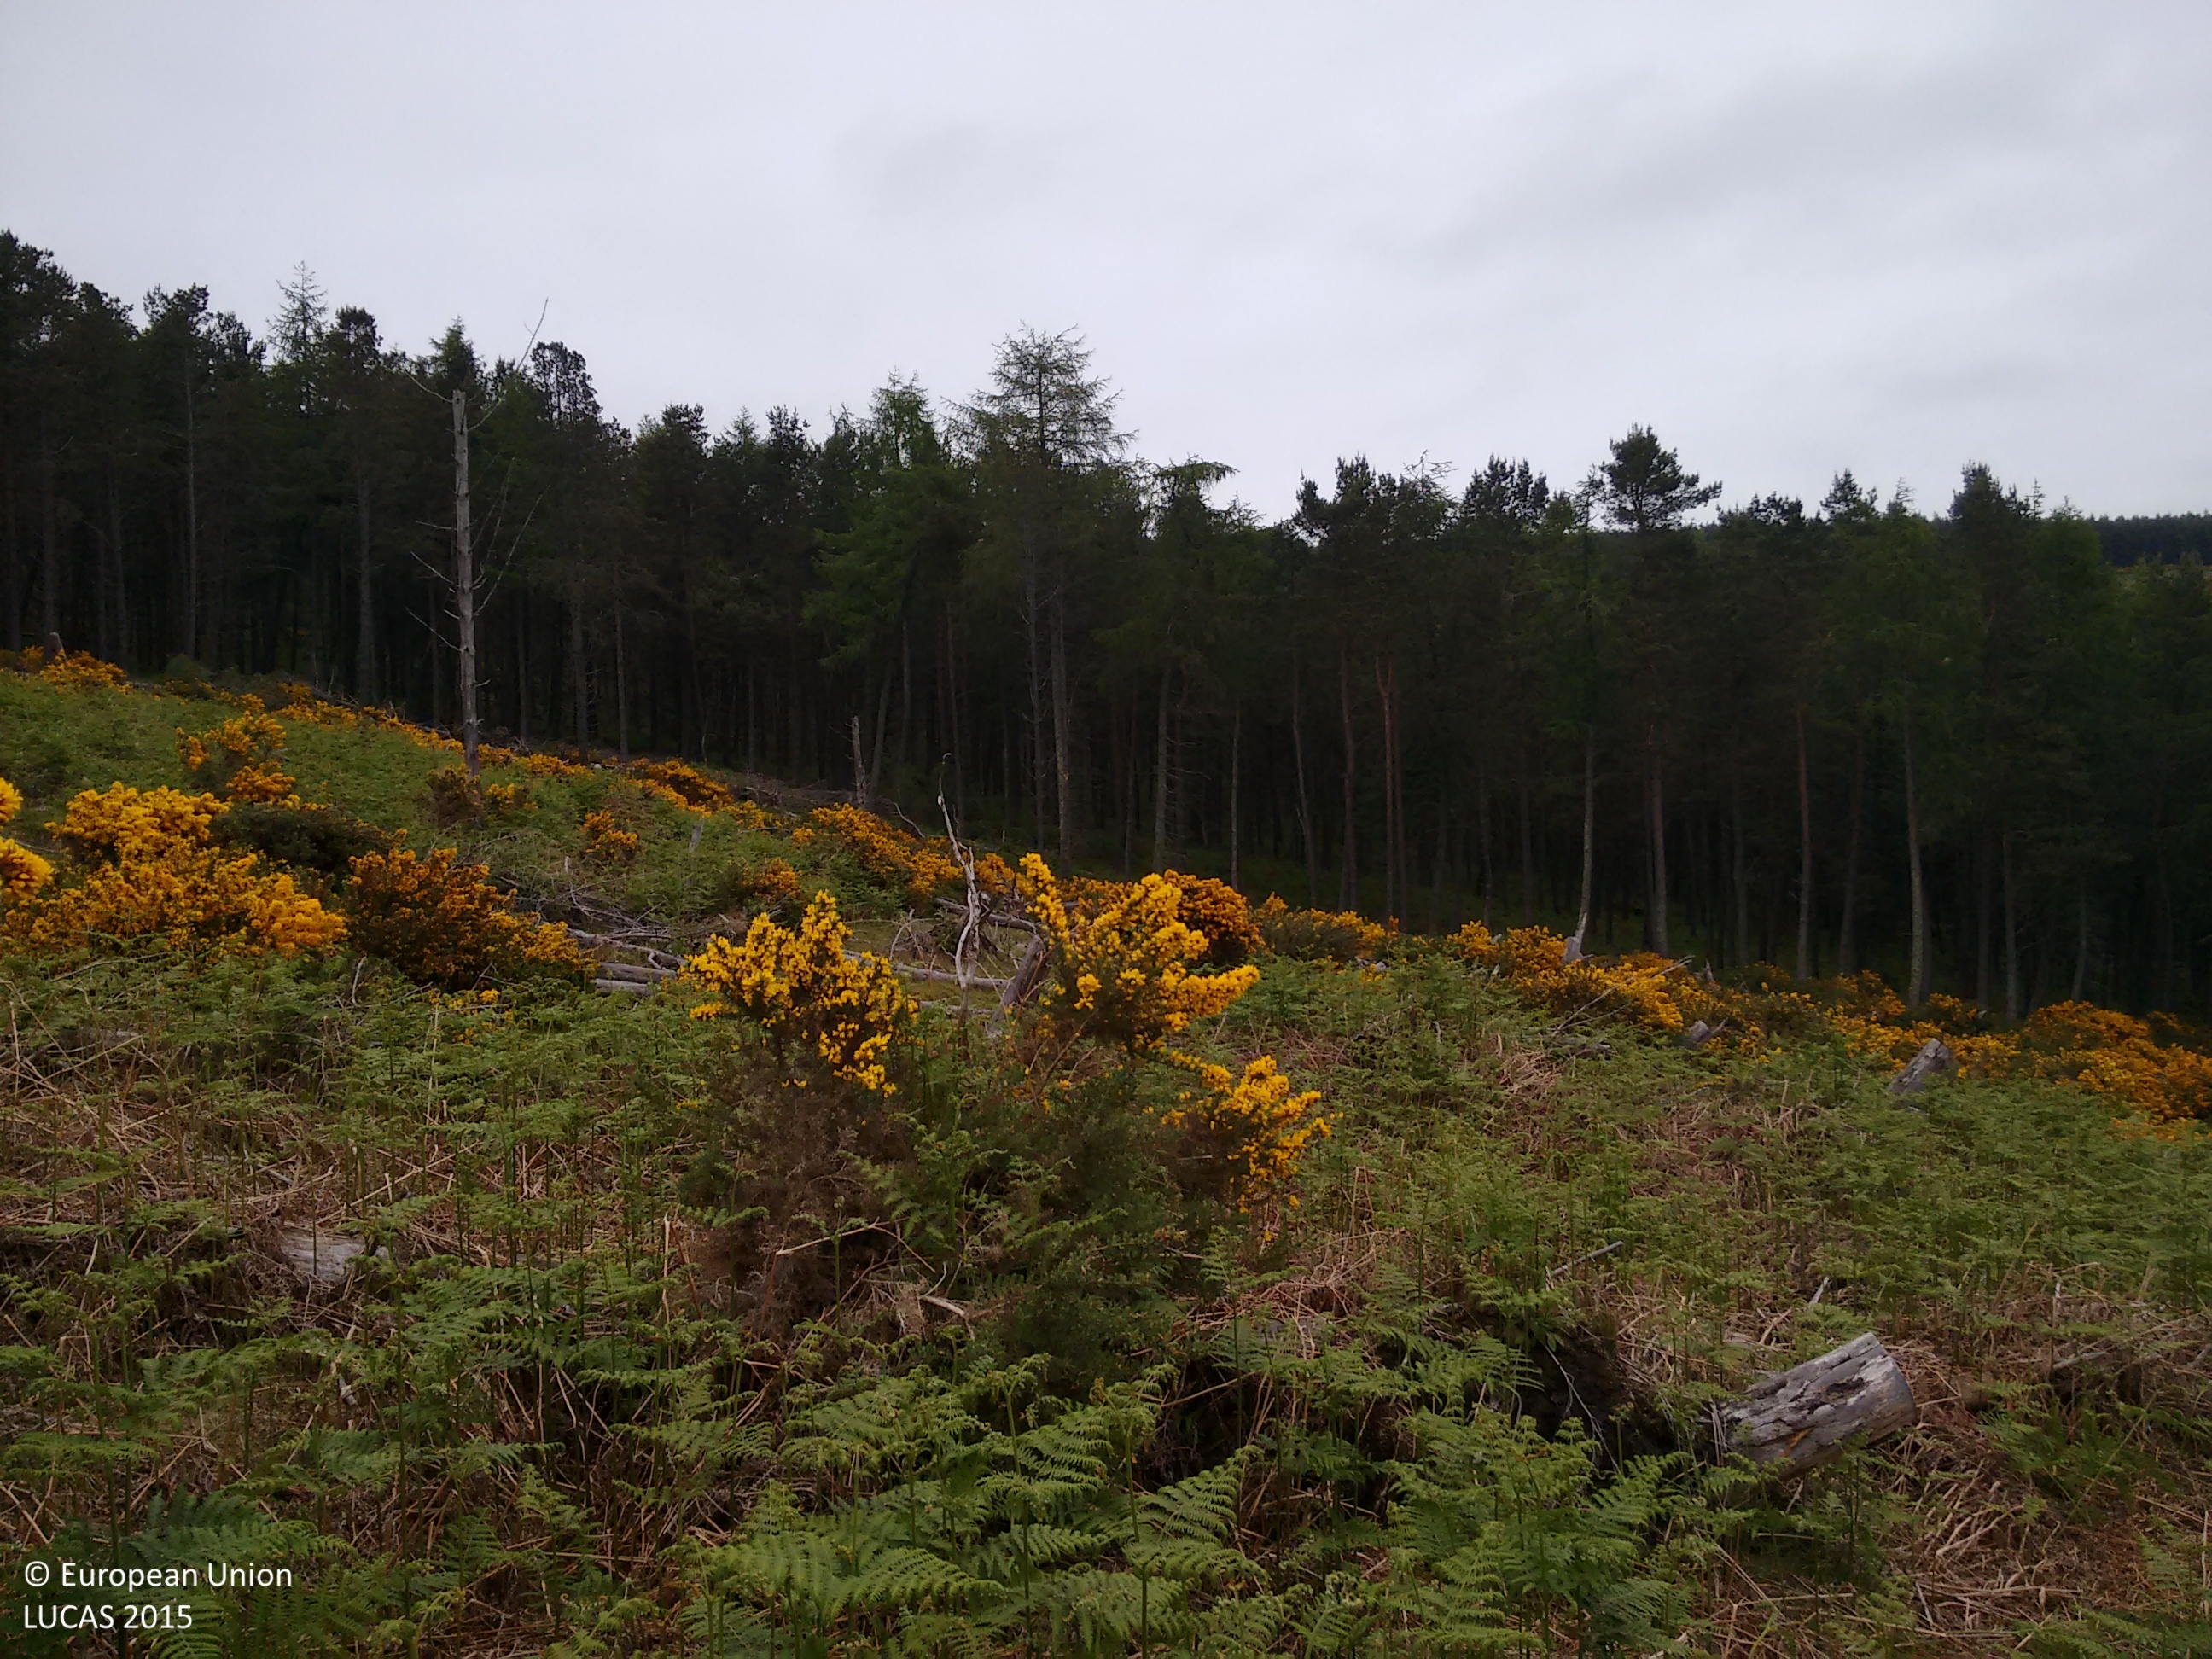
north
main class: Shrubland
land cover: Shrubland without tree cover
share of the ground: 50 - 75 %
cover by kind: shrubs 60 %, herbaceous plants 40 %
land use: Semi-natural and natural areas not in use
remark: Clear cut
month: June
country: GB
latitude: 57.1333
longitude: -2.7642
